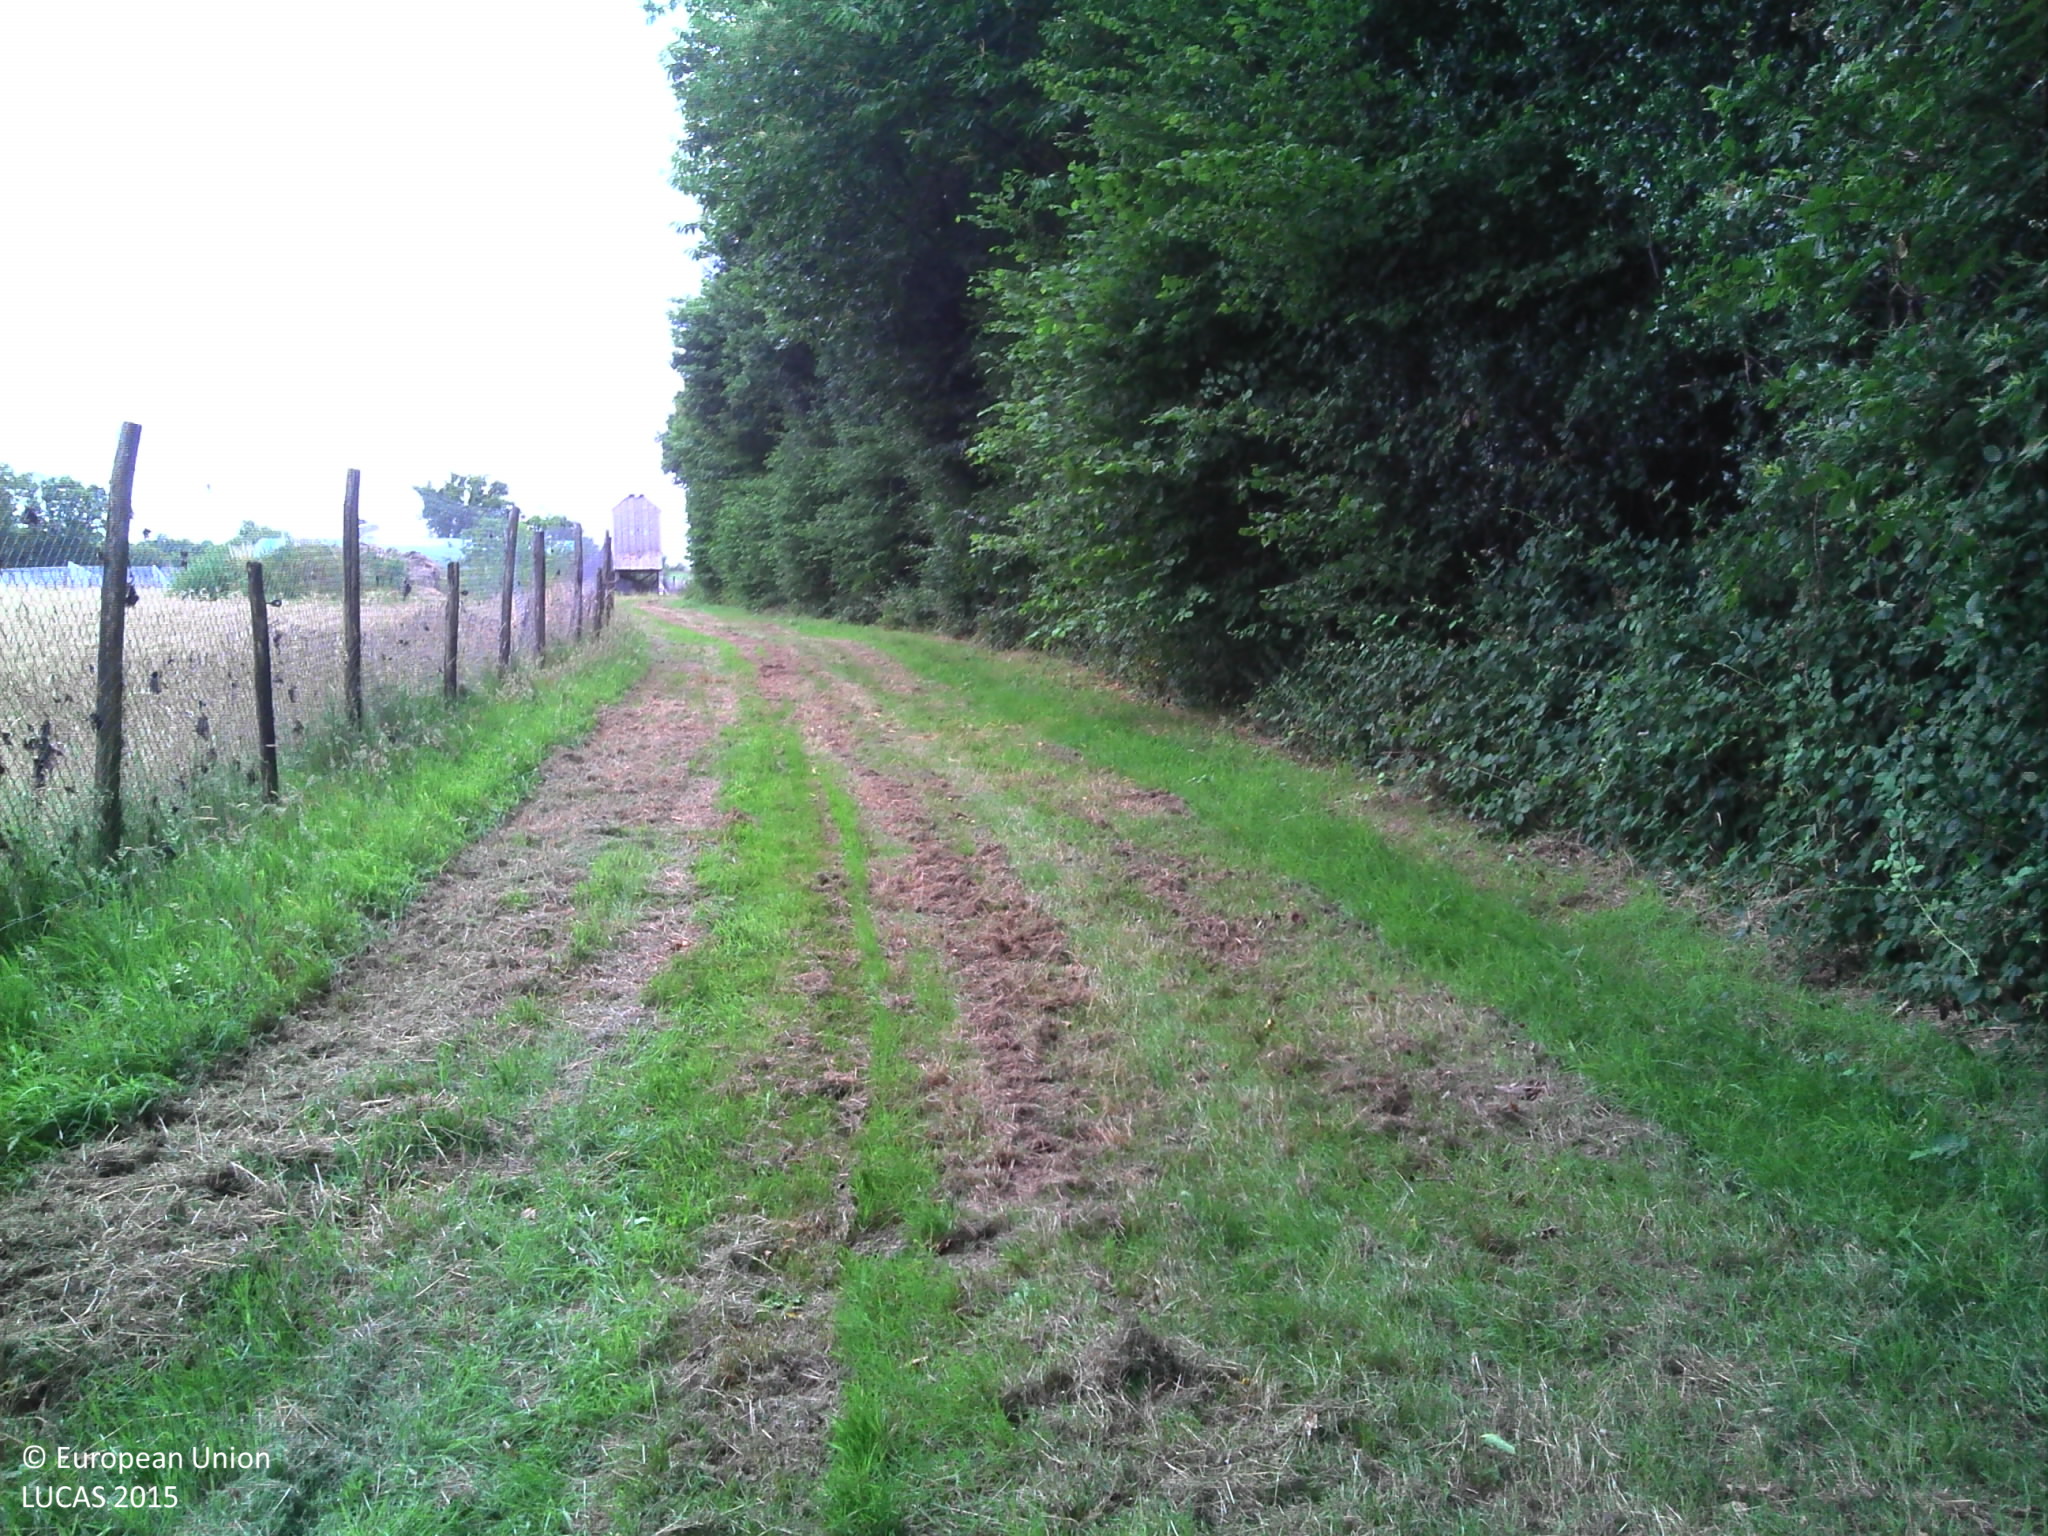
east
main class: Grassland
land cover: Grassland without tree/shrub cover
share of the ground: > 75 %
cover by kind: herbaceous plants 100 %
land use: Road transport
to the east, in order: Grassland without tree/shrub cover; Broadleaved woodland; Tracks; Broadleaved woodland; Grassland without tree/shrub cover; Fences; Grassland without tree/shrub cover; Single bushes/trees; Artificial constructions in urban areas; Spontaneously vegetated surfaces; Fences; Grassland without tree/shrub cover; Maize
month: July
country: FR
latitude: 47.0299
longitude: -1.7415
